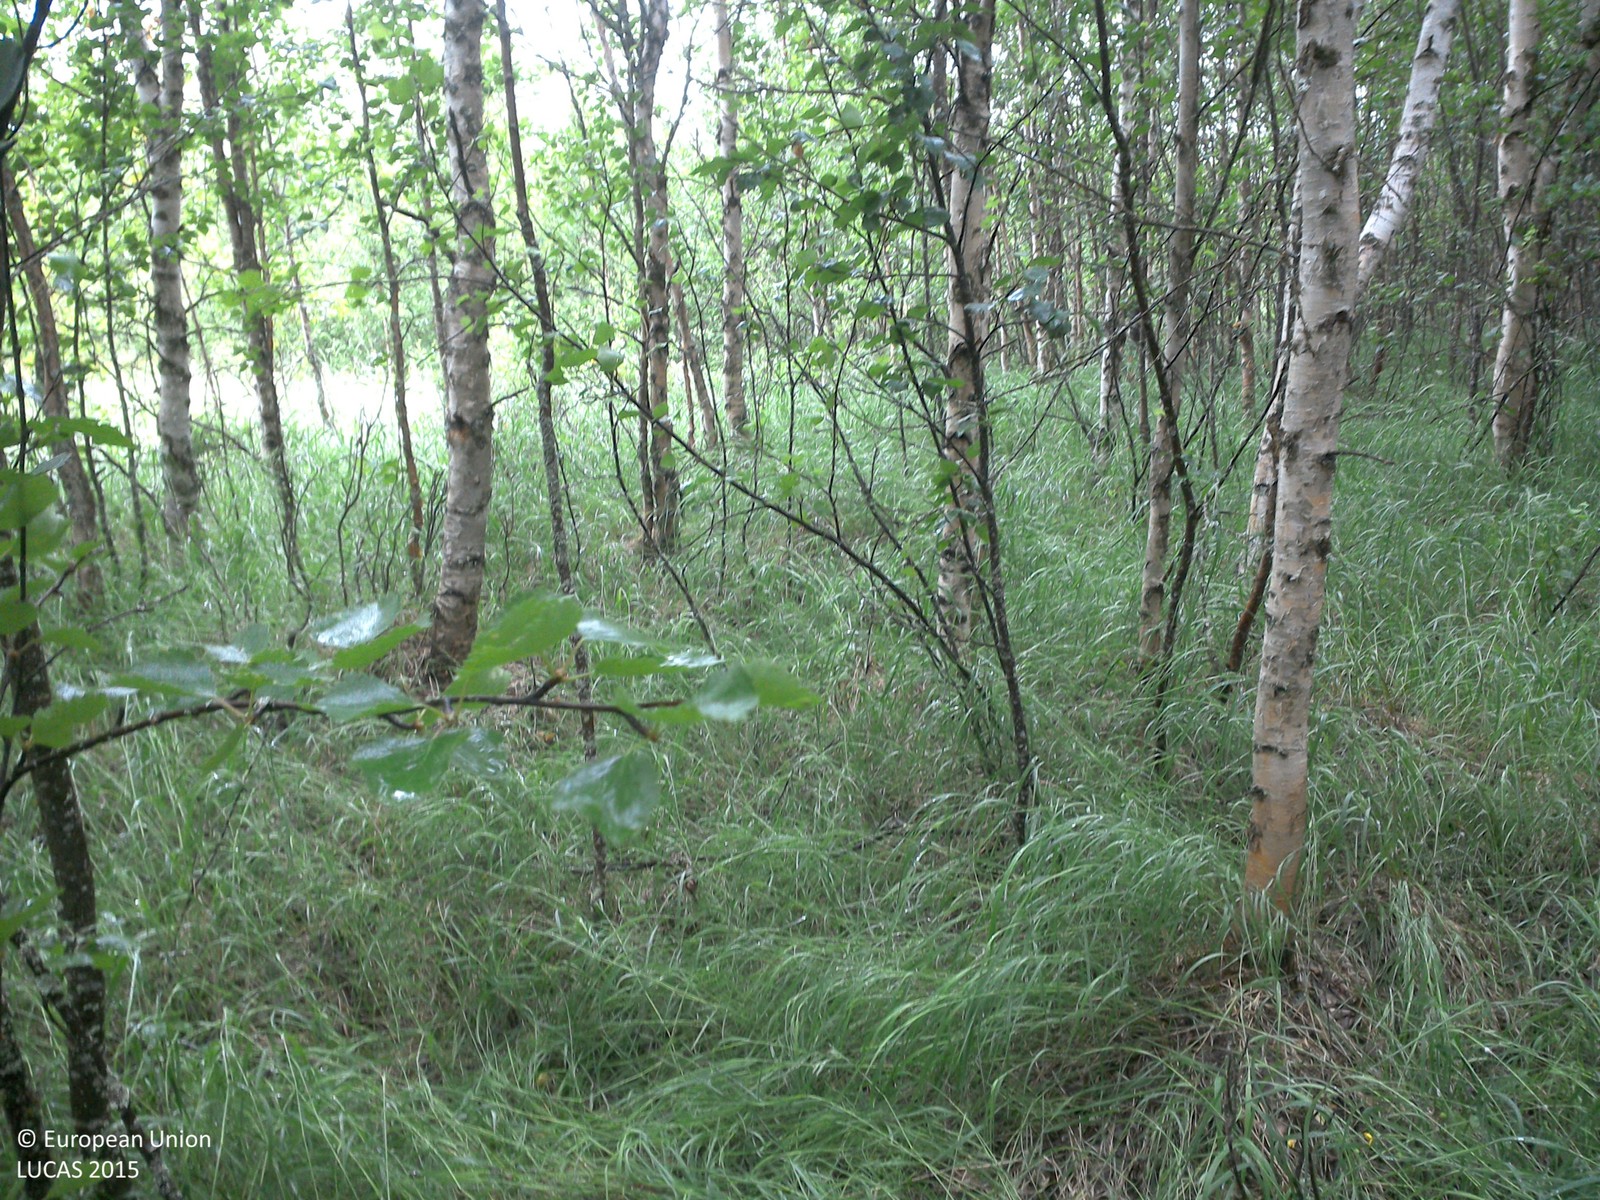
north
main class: Woodland
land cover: Broadleaved woodland
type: boreal forest
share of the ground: 50 - 75 %
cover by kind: broadleaved forest trees 60 %, herbaceous plants 40 %
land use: Forestry
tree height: > 5 m
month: July
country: SE
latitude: 67.6720
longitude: 21.6238
